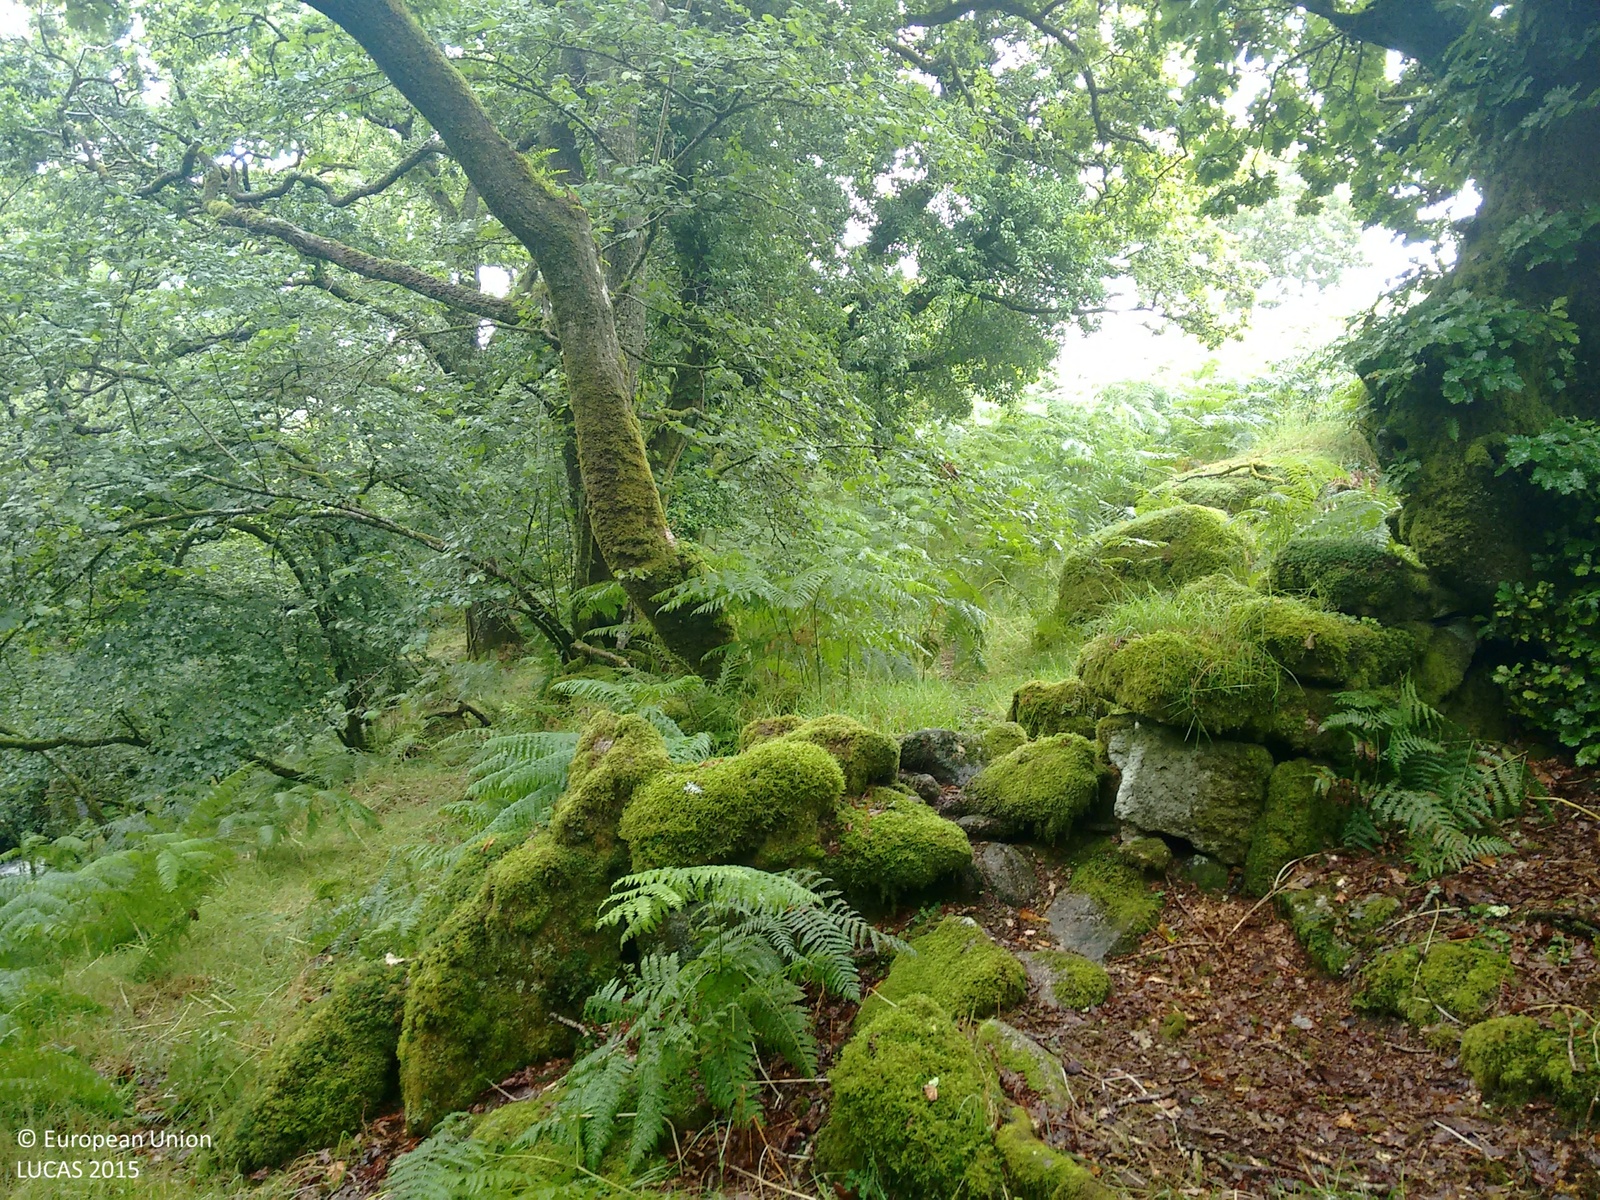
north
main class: Woodland
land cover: Broadleaved woodland
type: acidophilous oak and oak-birch forest
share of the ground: > 75 %
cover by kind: broadleaved forest trees 100 %
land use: Semi-natural and natural areas not in use
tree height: > 5 m
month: August
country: GB
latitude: 50.5498
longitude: -4.0528
